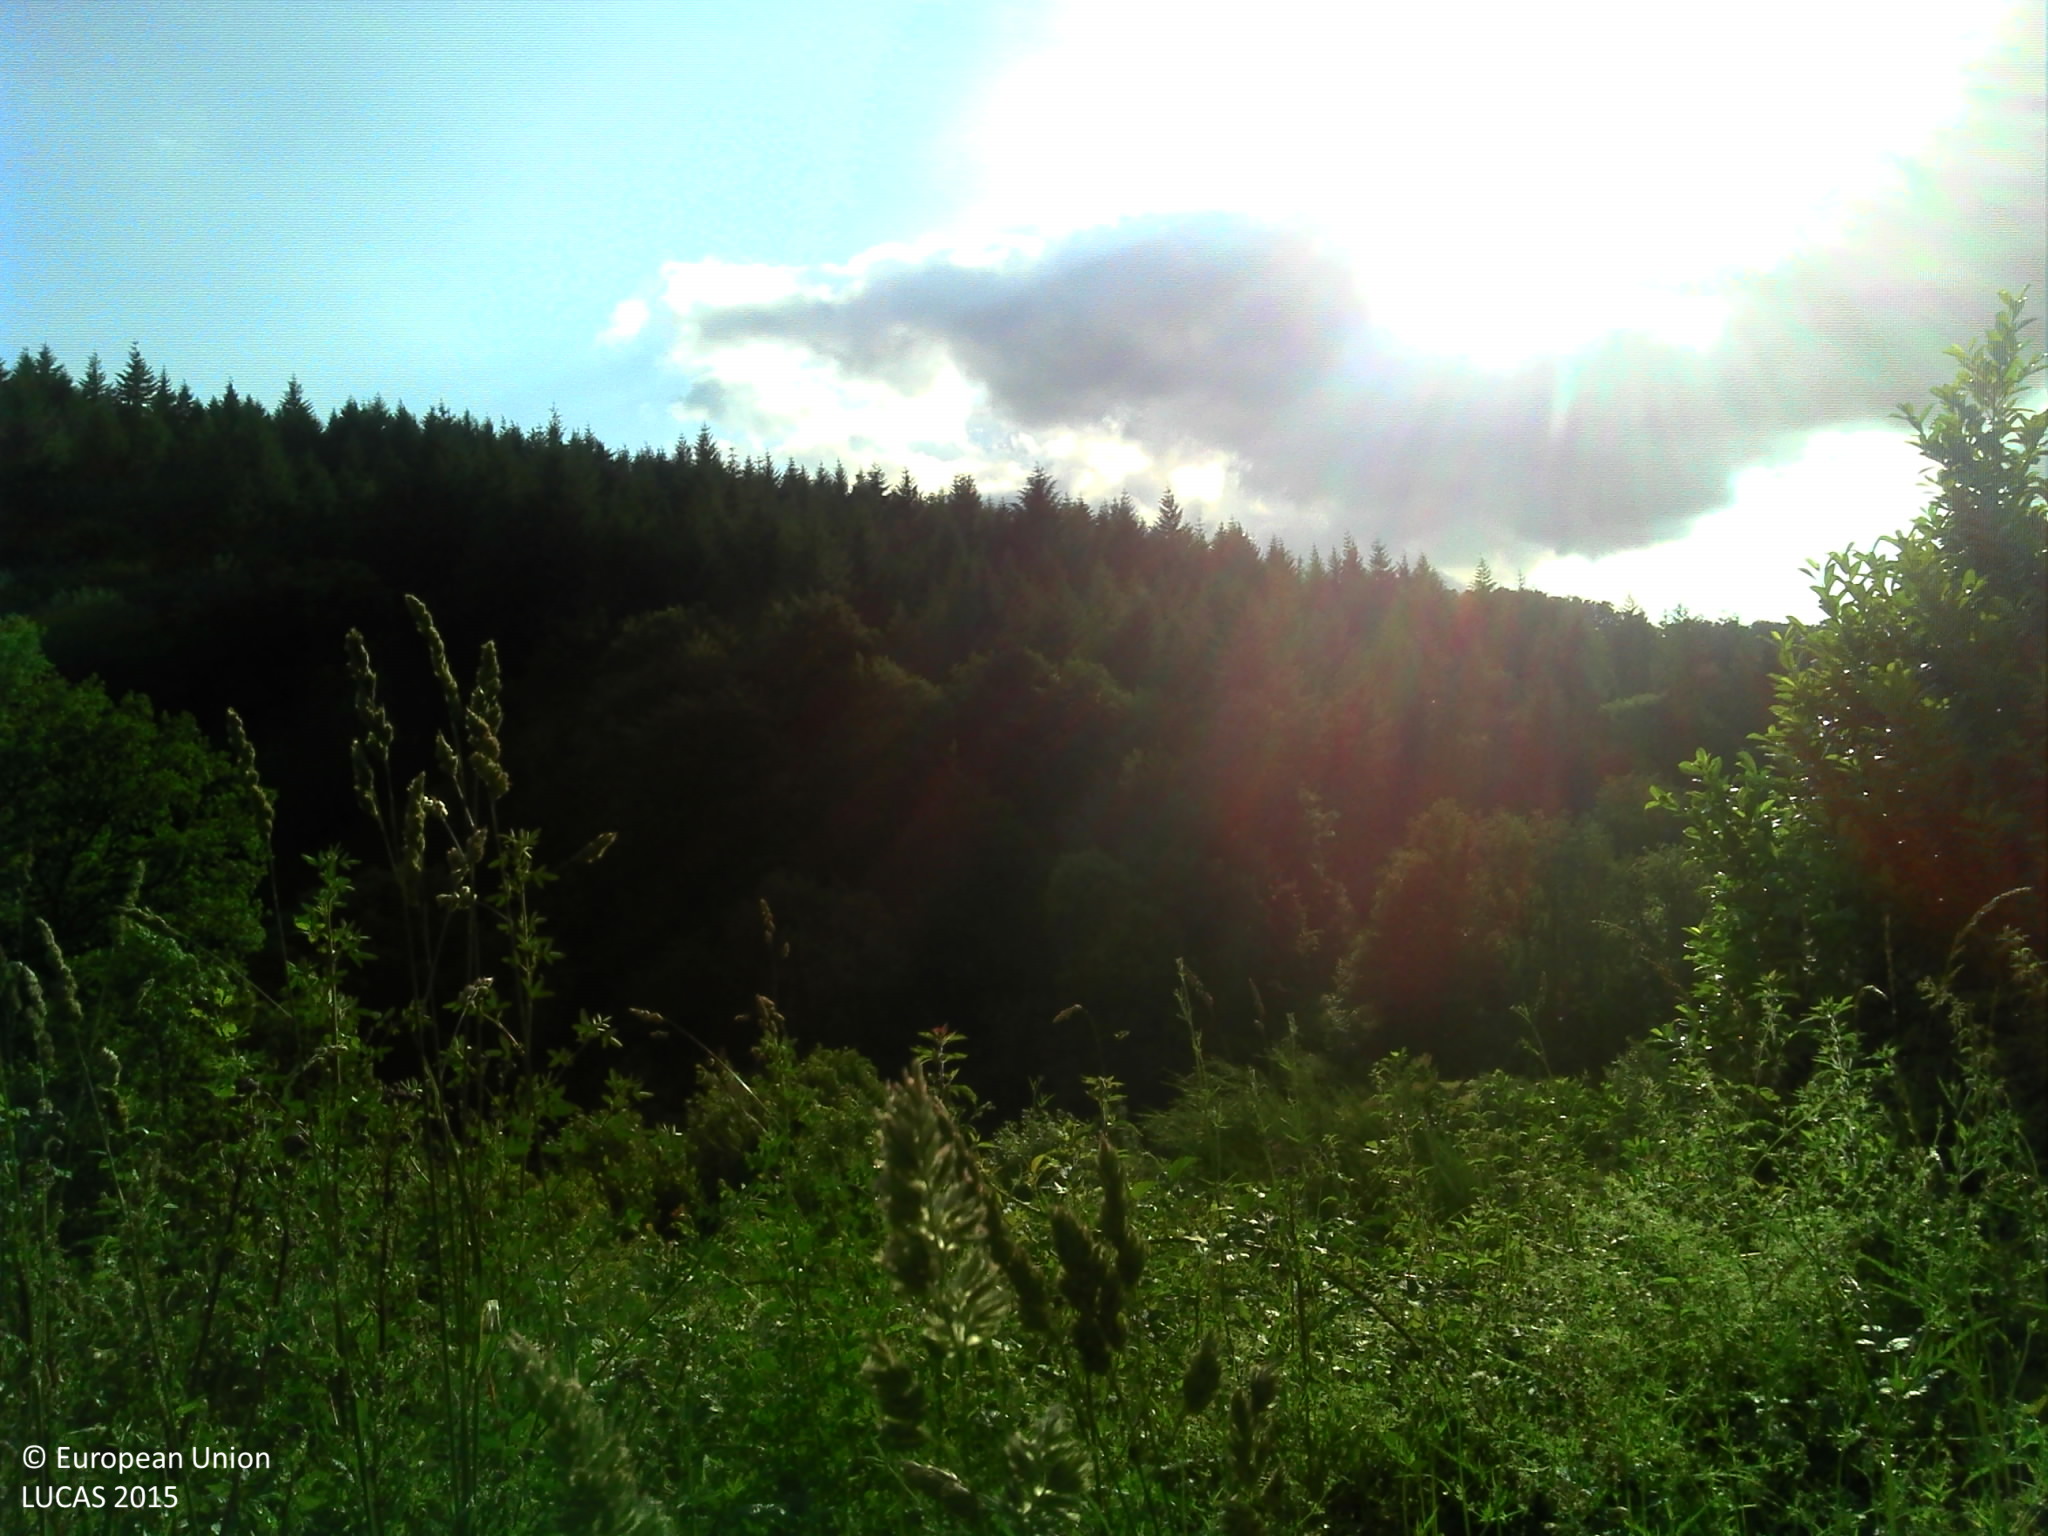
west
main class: Woodland
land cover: Spruce dominated coniferous woodland
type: exotic forest
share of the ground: > 75 %
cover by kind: coniferous forest trees 100 %
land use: Forestry
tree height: > 5 m
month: November
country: FR
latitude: 43.7936
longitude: 2.5615
